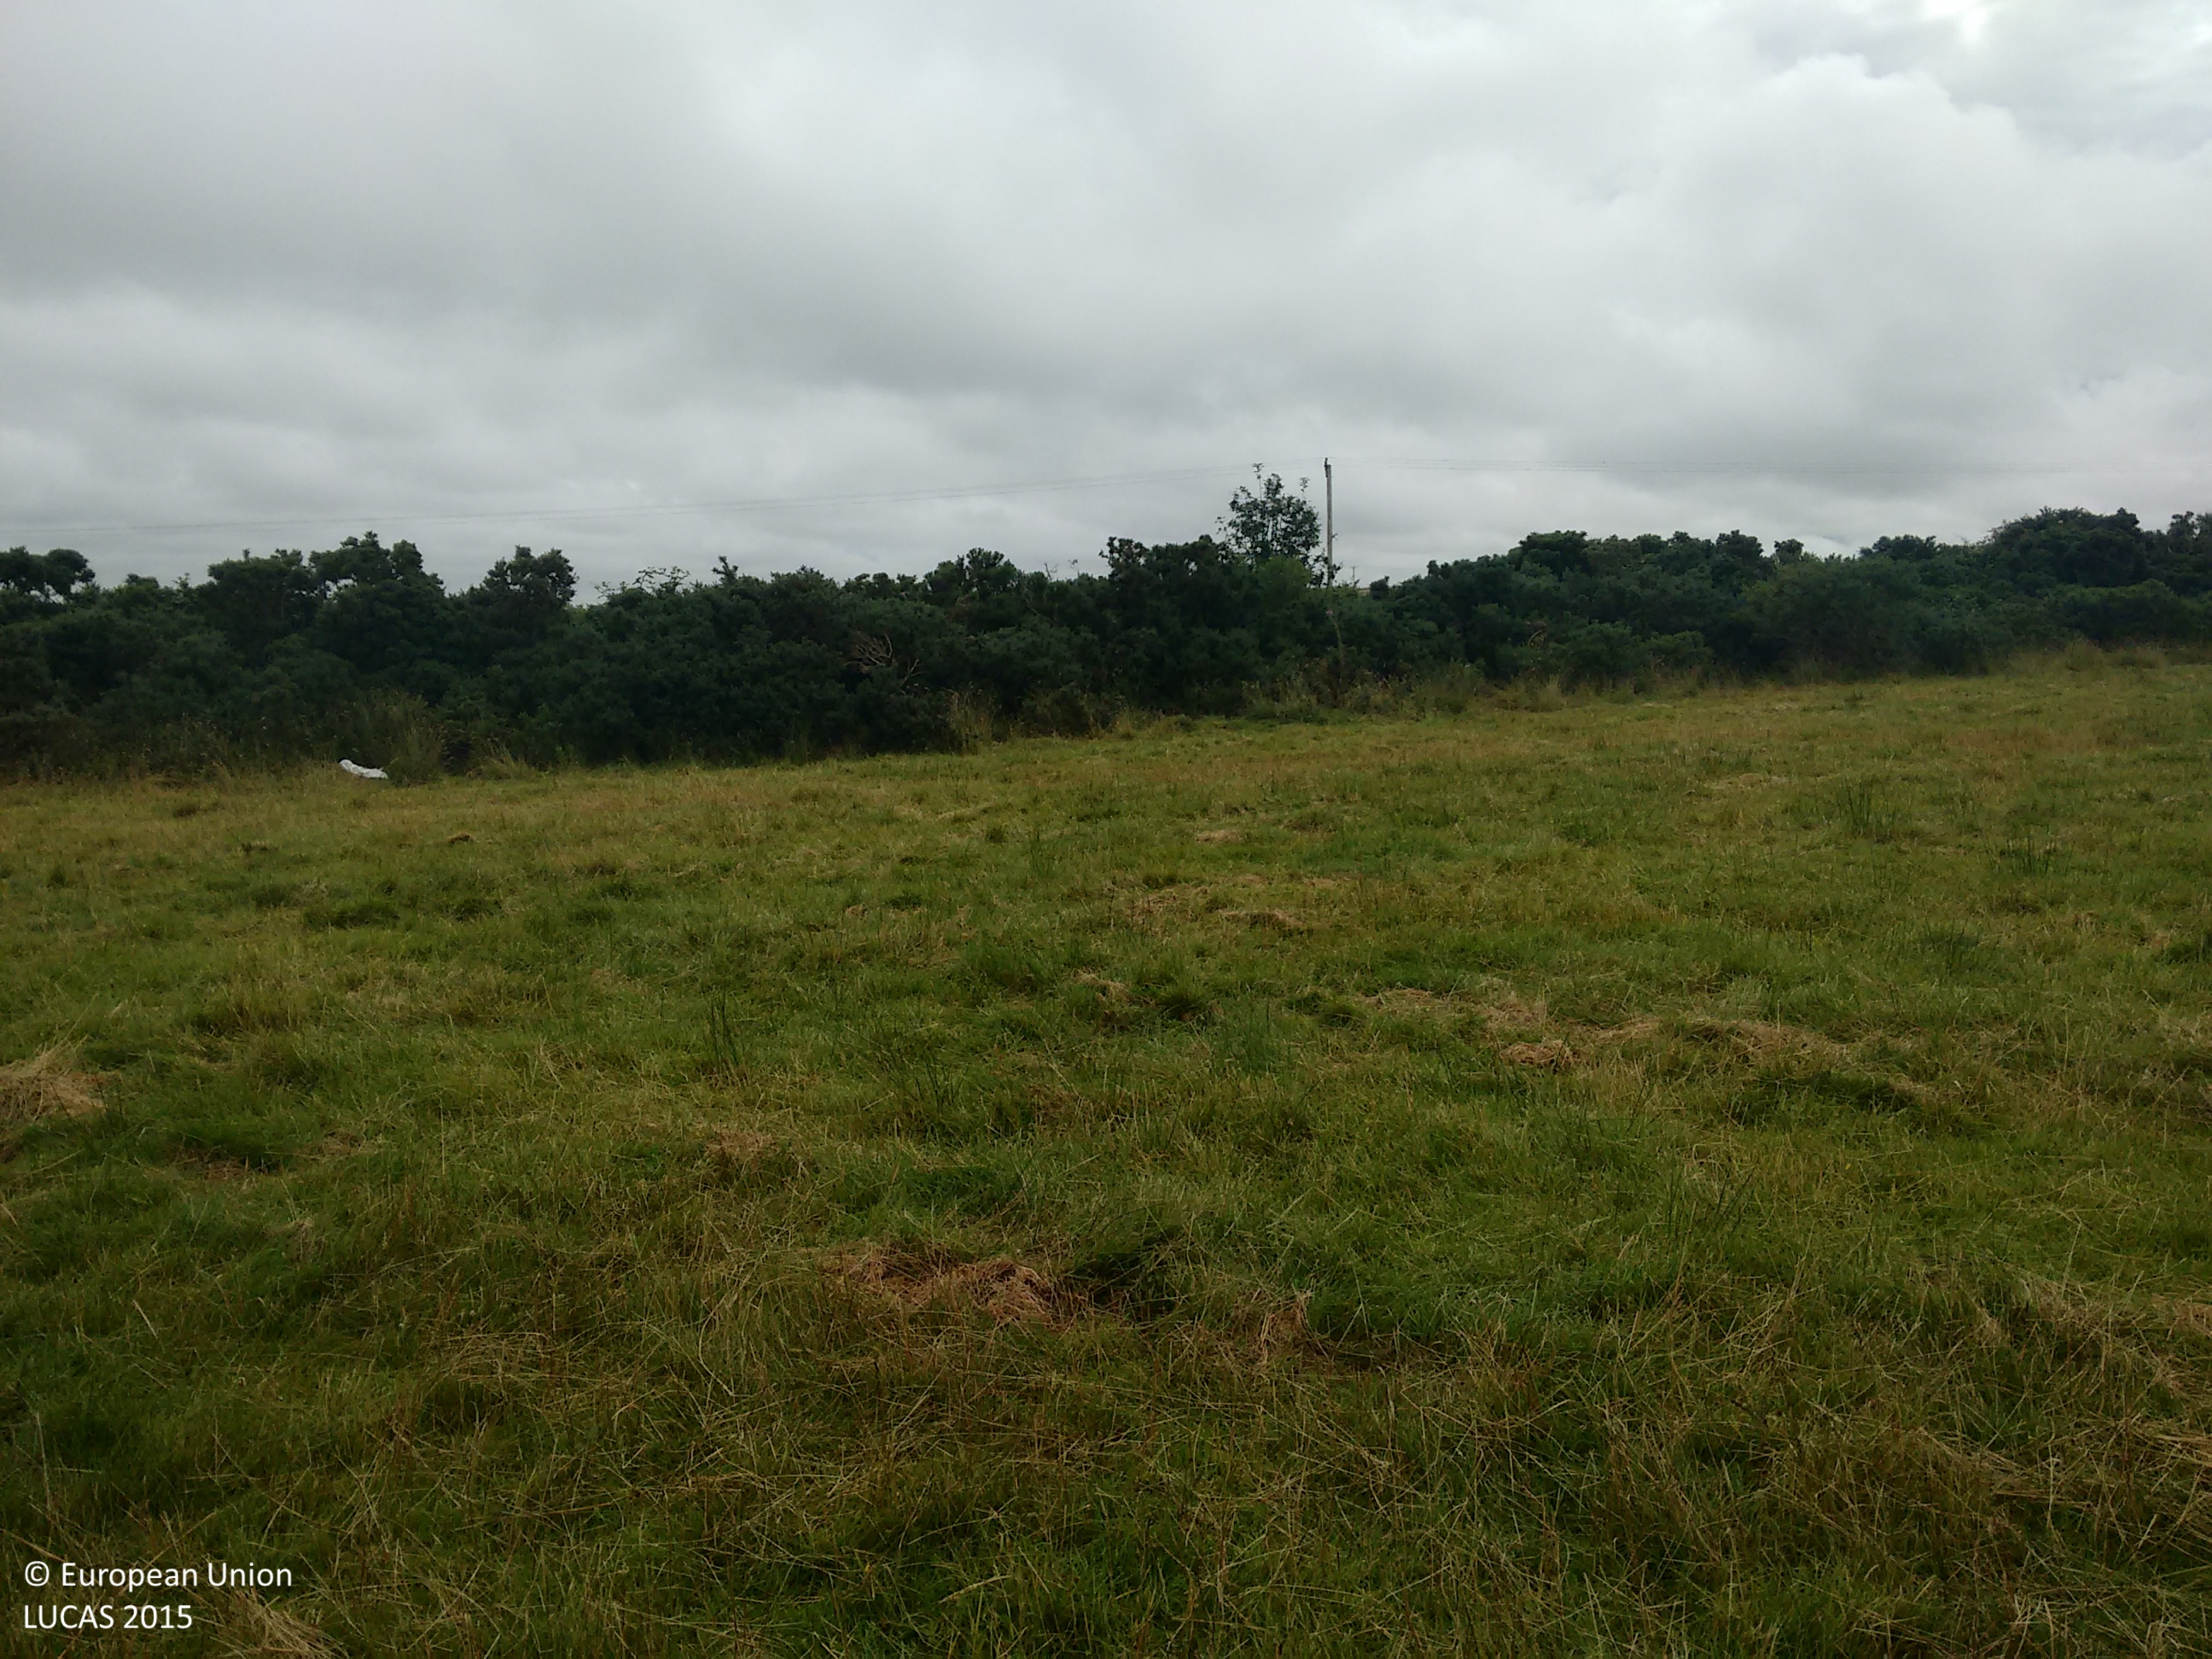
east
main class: Grassland
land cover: Grassland without tree/shrub cover
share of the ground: > 75 %
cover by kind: herbaceous plants 100 %
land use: Agriculture (excluding fallow land and kitchen gardens)
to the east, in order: Grassland without tree/shrub cover; Shrubland without tree cover; Fences; Shrubland without tree cover; Grassland without tree/shrub cover; Electric lines; Grassland without tree/shrub cover
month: August
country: GB
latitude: 57.7867
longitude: -4.0567
